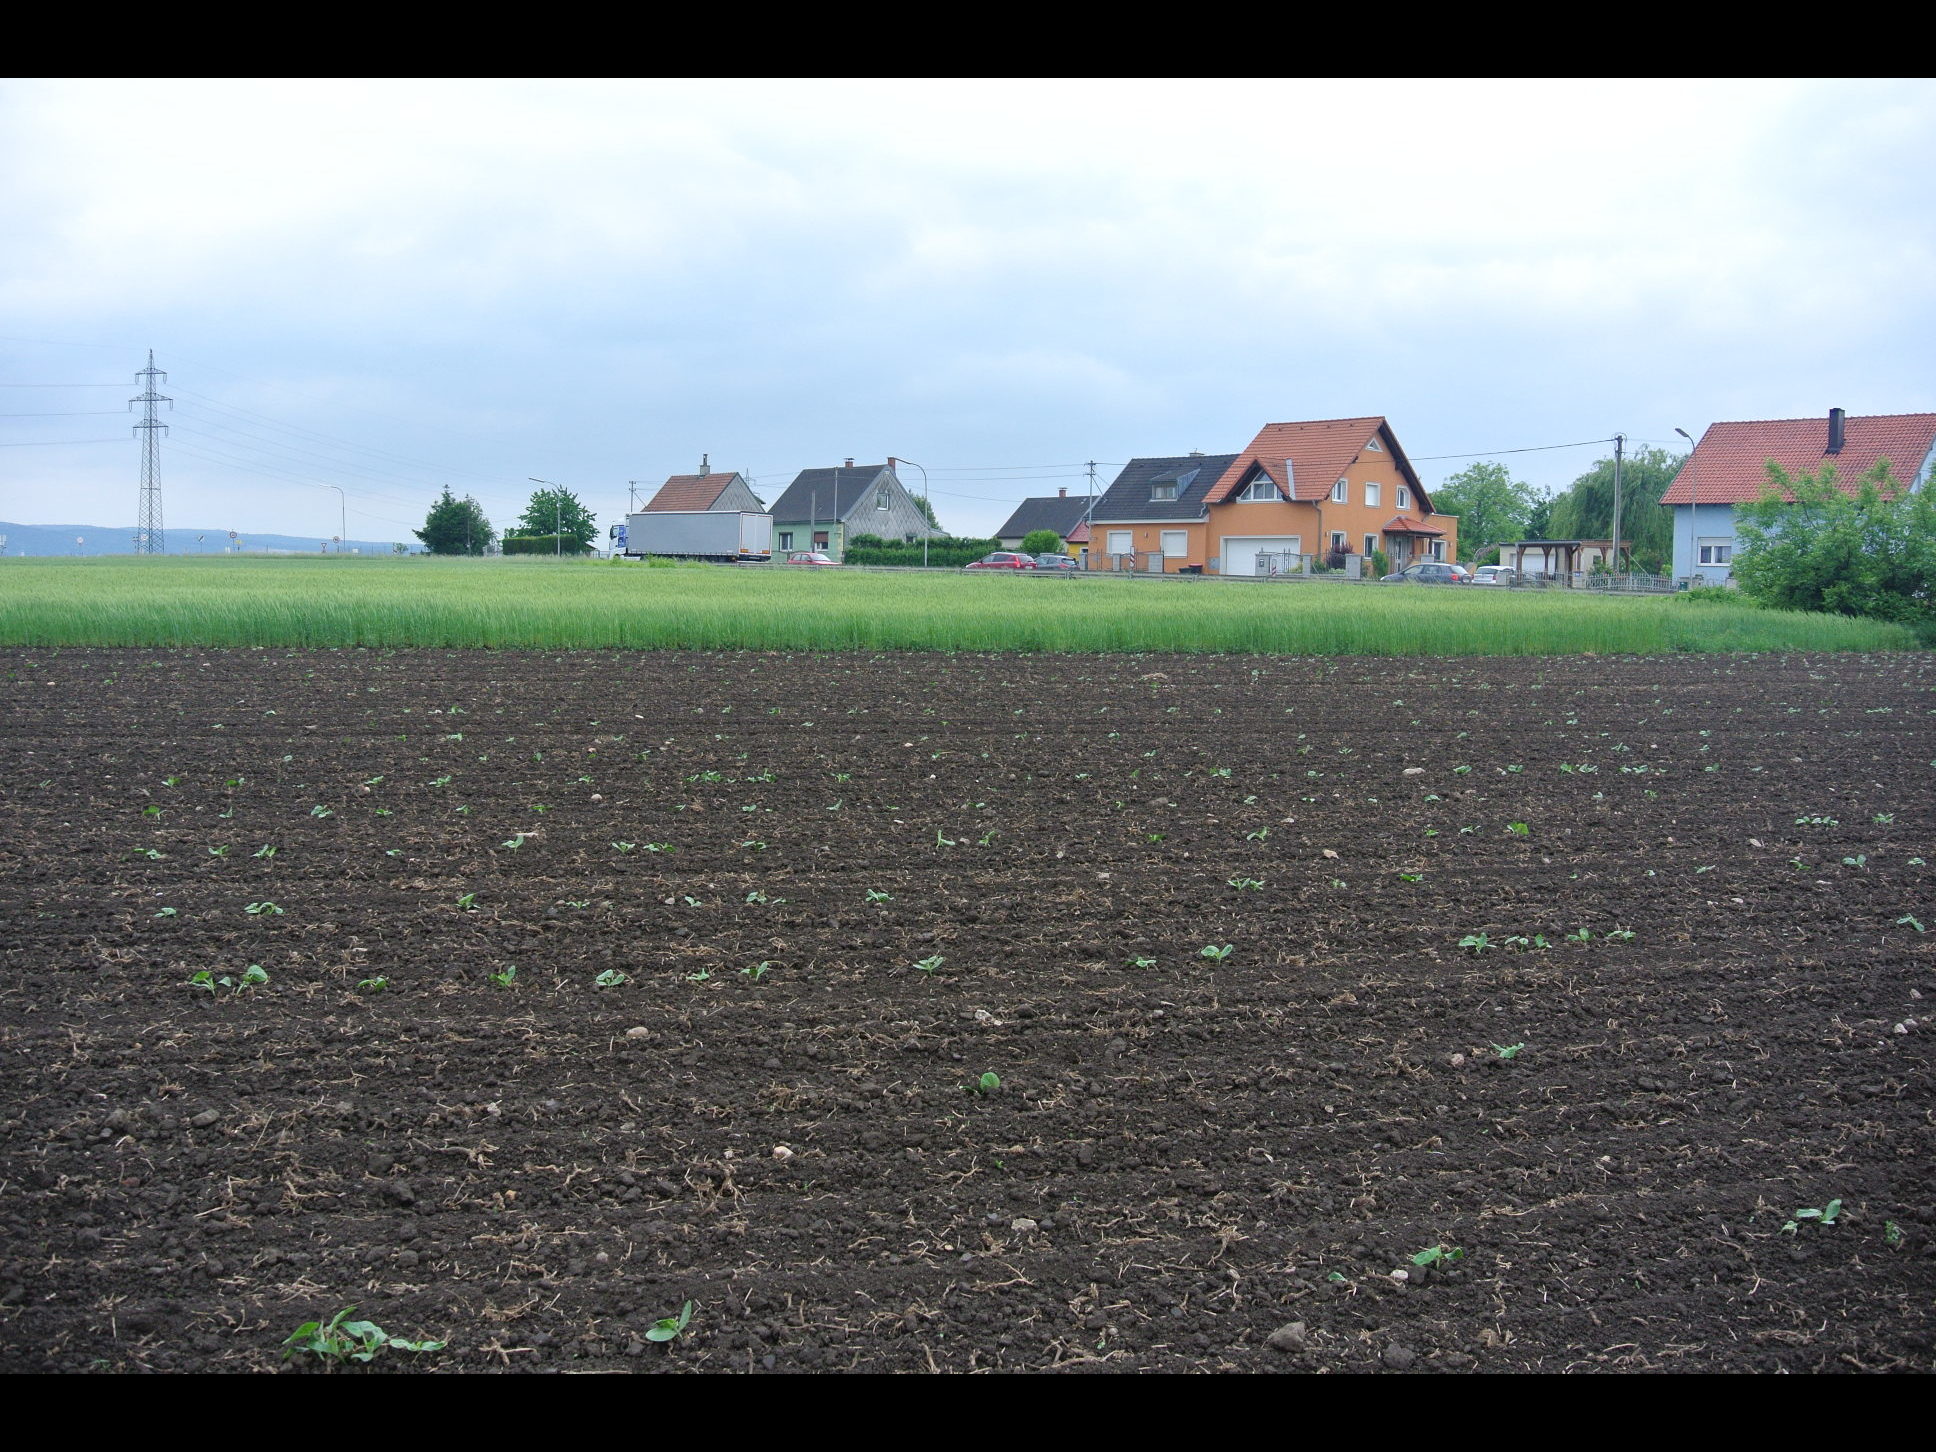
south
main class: Cropland
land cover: Other fibre and oleaginous crops
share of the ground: < 10 %
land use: Agriculture (excluding fallow land and kitchen gardens)
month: May
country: AT
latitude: 48.0084
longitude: 16.5871
